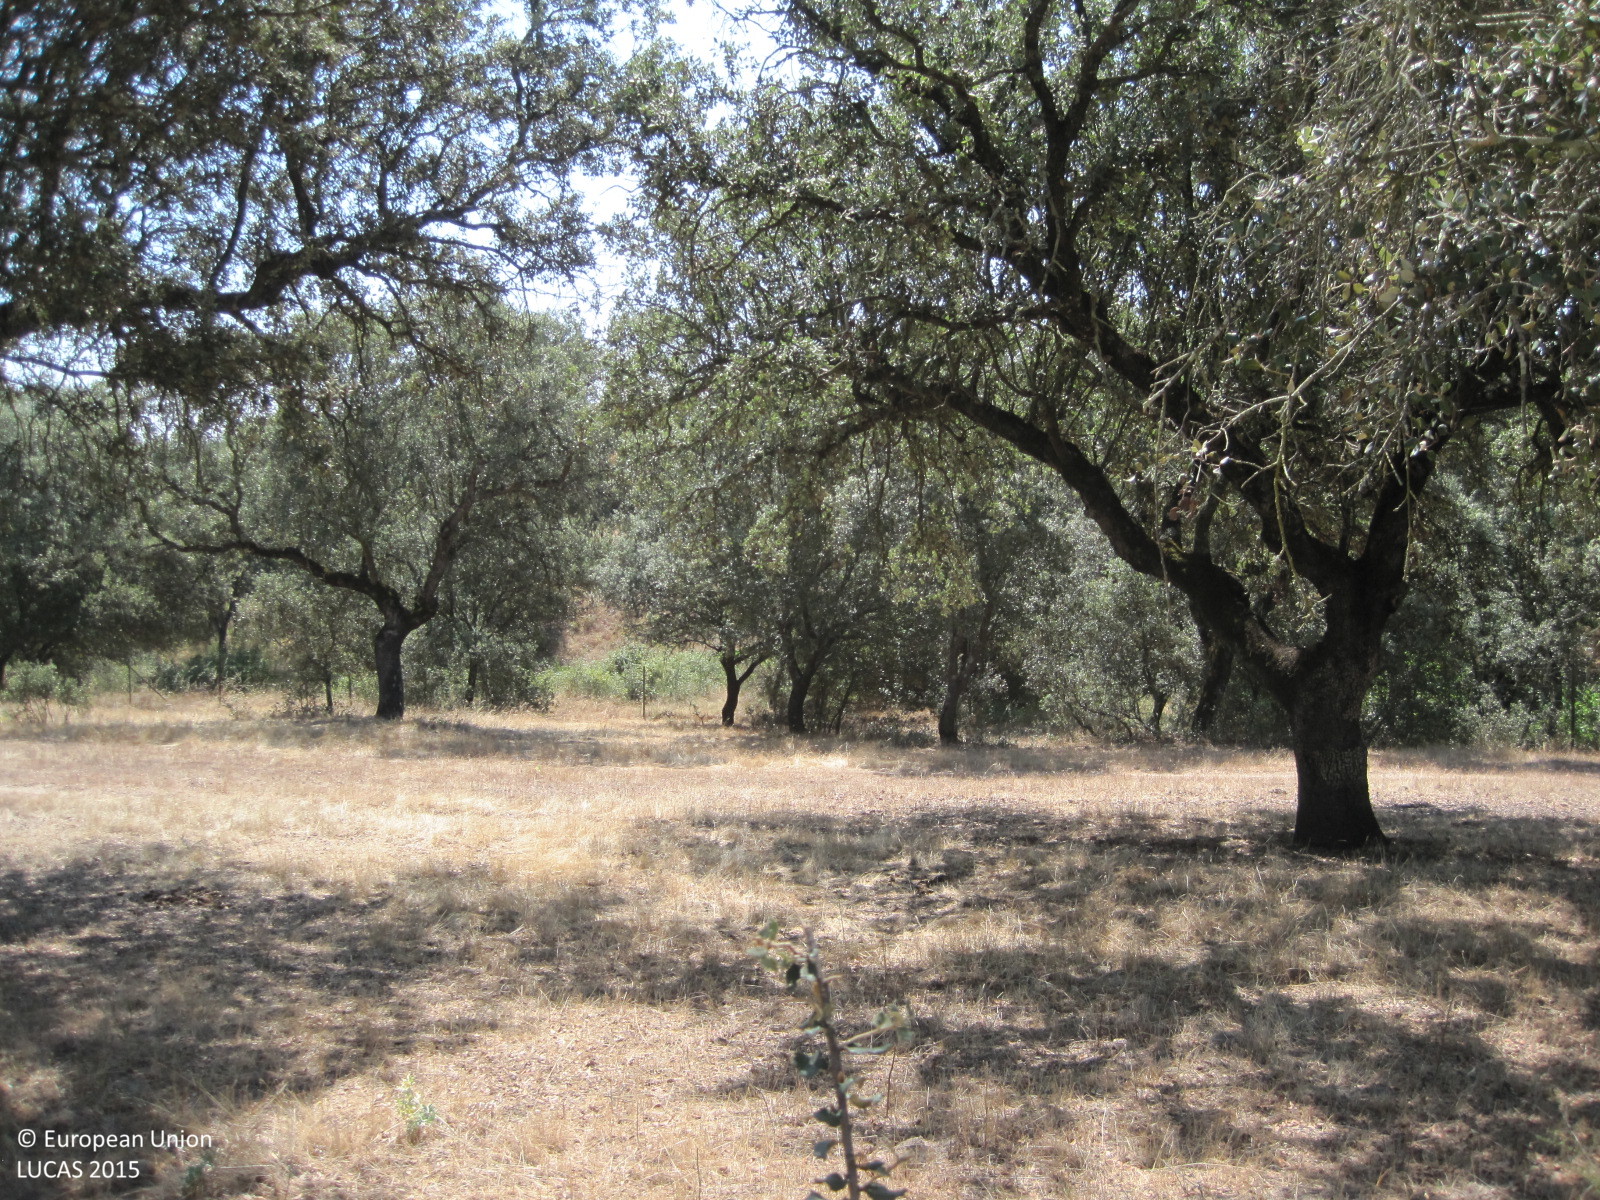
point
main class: Woodland
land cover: Broadleaved woodland
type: broadleaved evergreen forest
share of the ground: 50 - 75 %
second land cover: Shrubland without tree cover
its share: 50 - 75 %
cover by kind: broadleaved forest trees 65 %, shrubs 25 %, herbaceous plants 10 %
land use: Forestry
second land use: Agriculture (excluding fallow land and kitchen gardens)
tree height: > 5 m
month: July
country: ES
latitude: 39.9518
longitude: -5.1168
